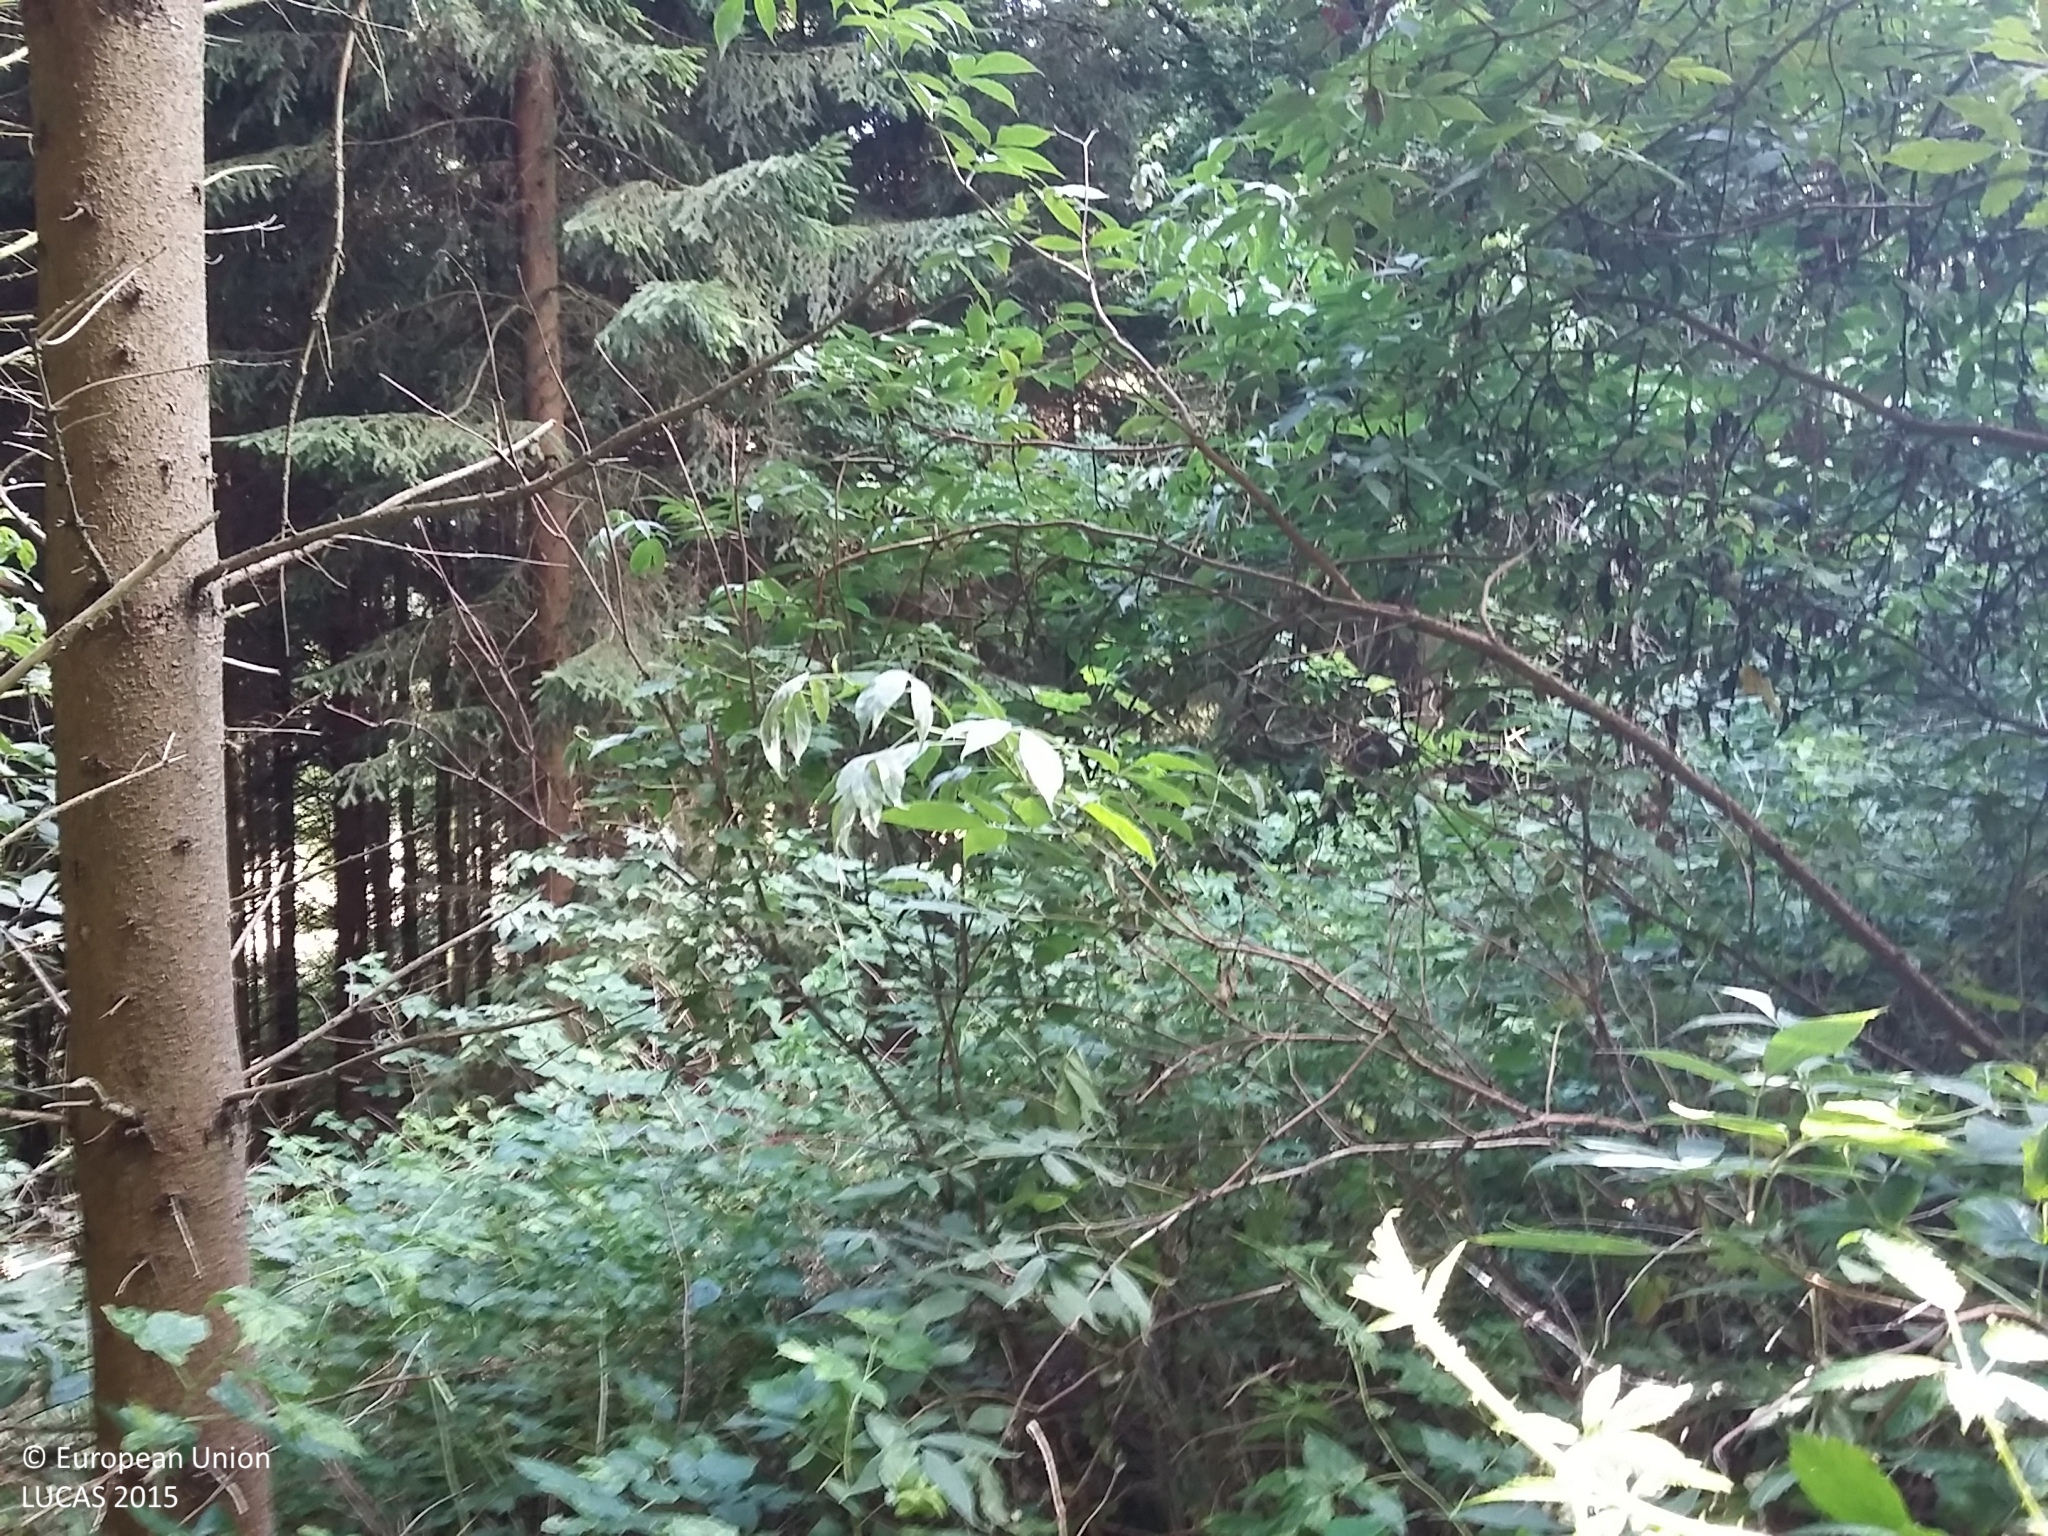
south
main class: Woodland
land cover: Spruce dominated coniferous woodland
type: hemiboreal forest and nemoral coniferous forest and mixed broadleaved-coniferous forest
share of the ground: > 75 %
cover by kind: coniferous forest trees 75 %, broadleaved forest trees 15 %, herbaceous plants 10 %
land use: Forestry
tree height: > 5 m
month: August
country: DK
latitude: 55.1991
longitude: 14.7603
